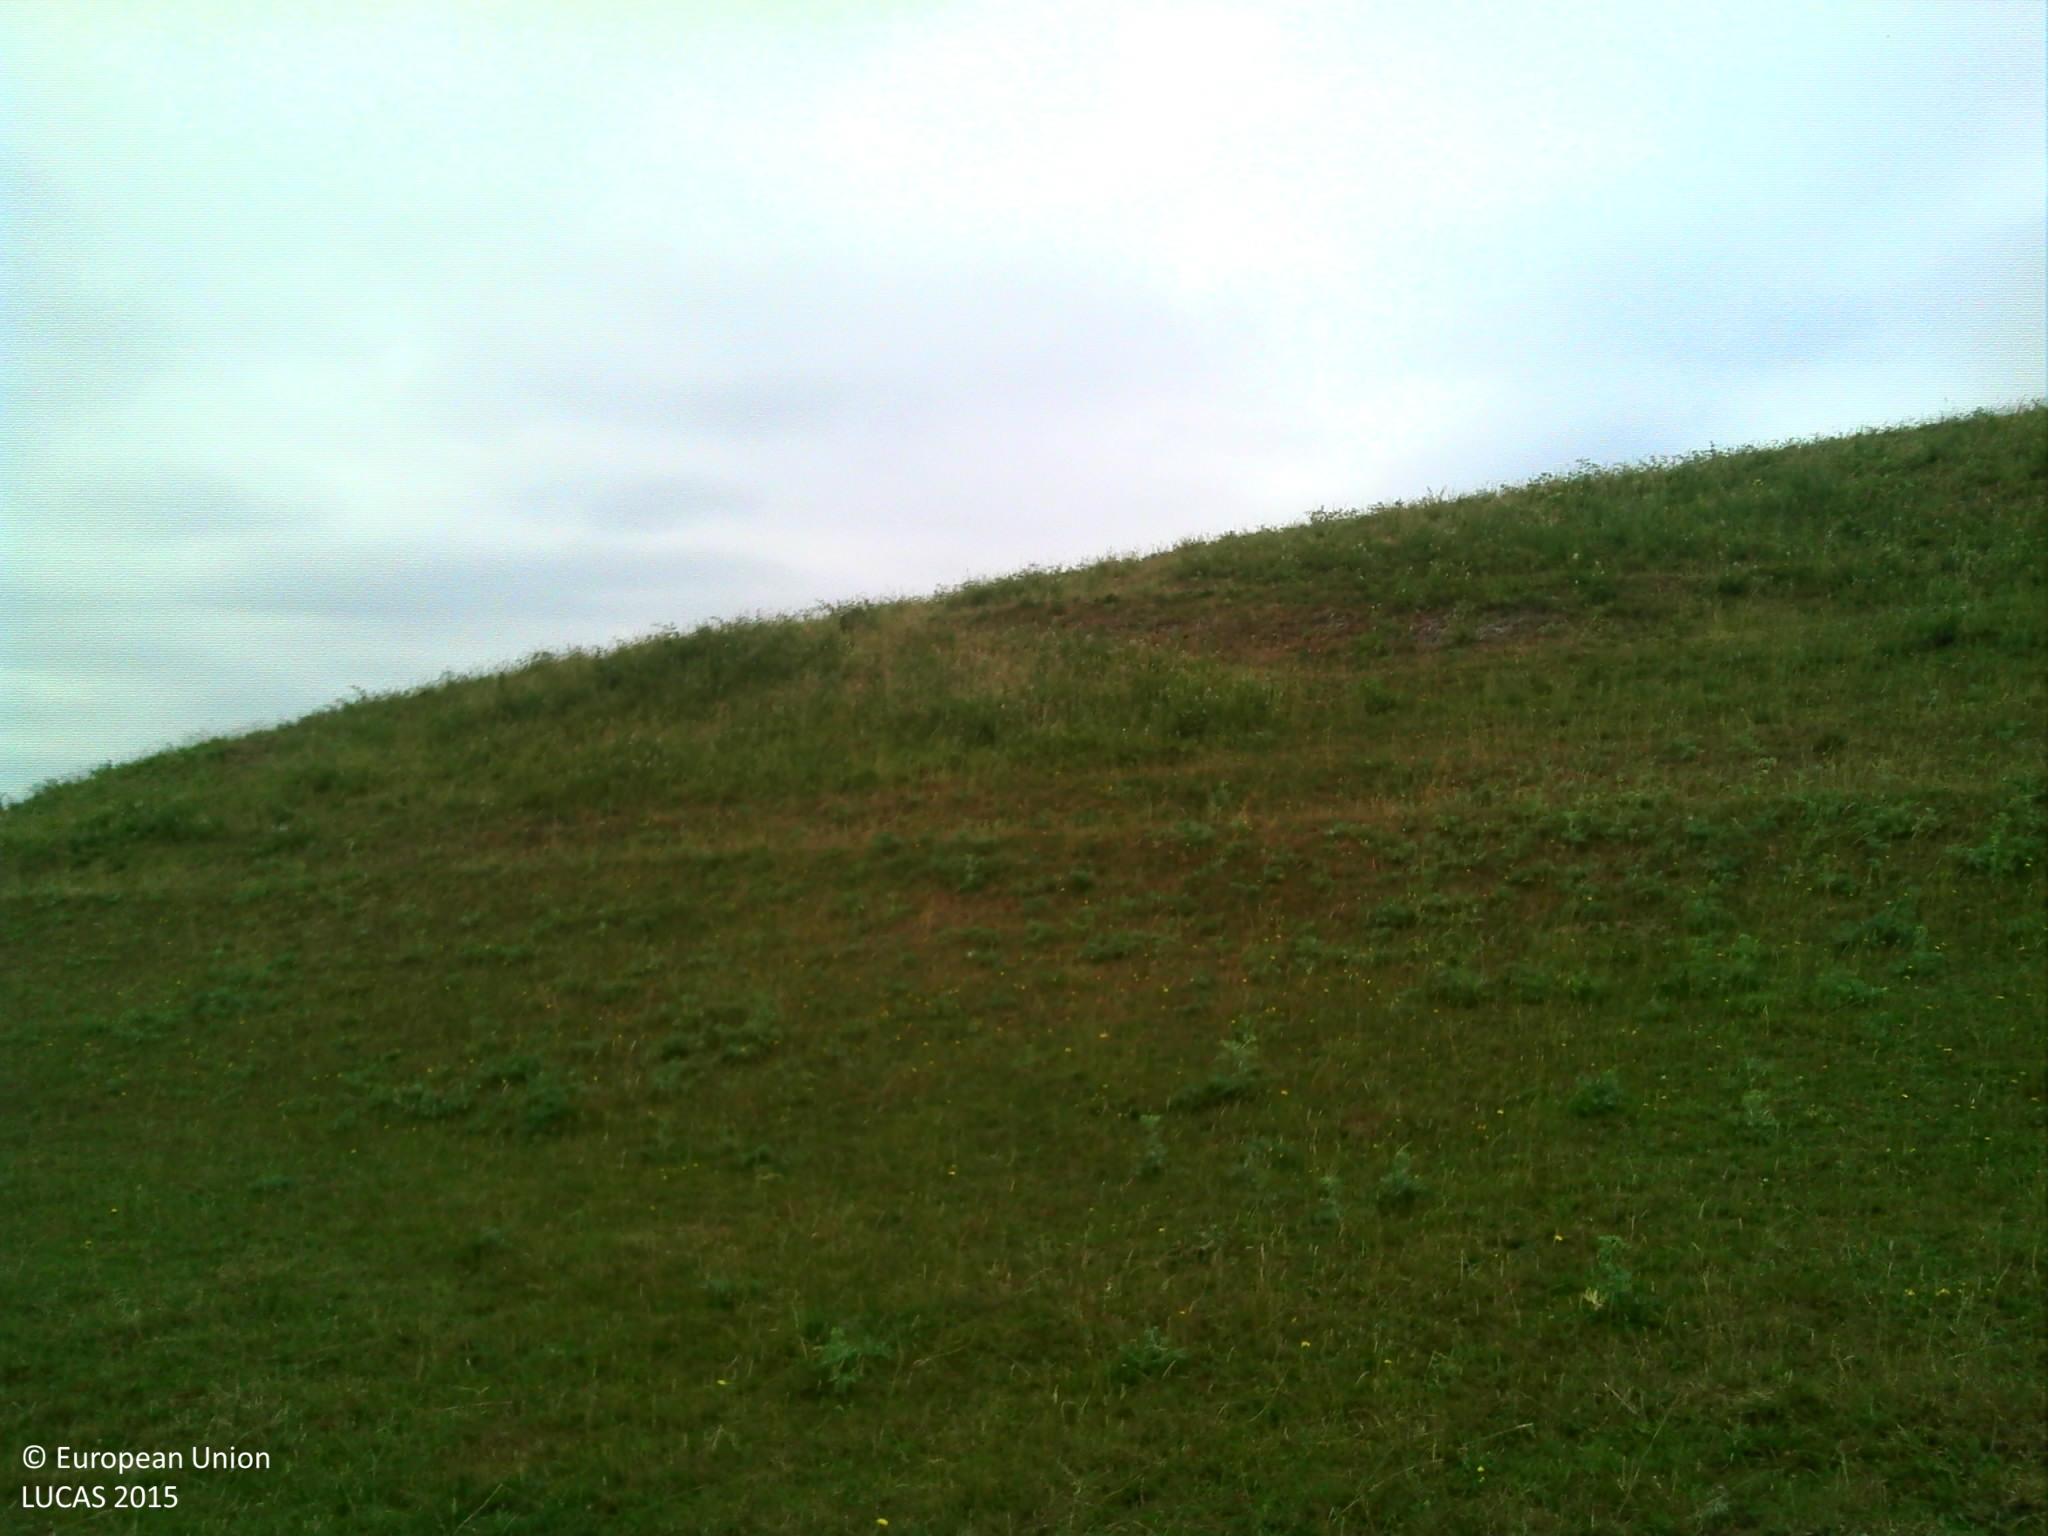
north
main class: Grassland
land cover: Grassland without tree/shrub cover
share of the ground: > 75 %
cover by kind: herbaceous plants 100 %
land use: Agriculture (excluding fallow land and kitchen gardens)
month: June
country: FR
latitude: 46.5303
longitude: 4.7737
